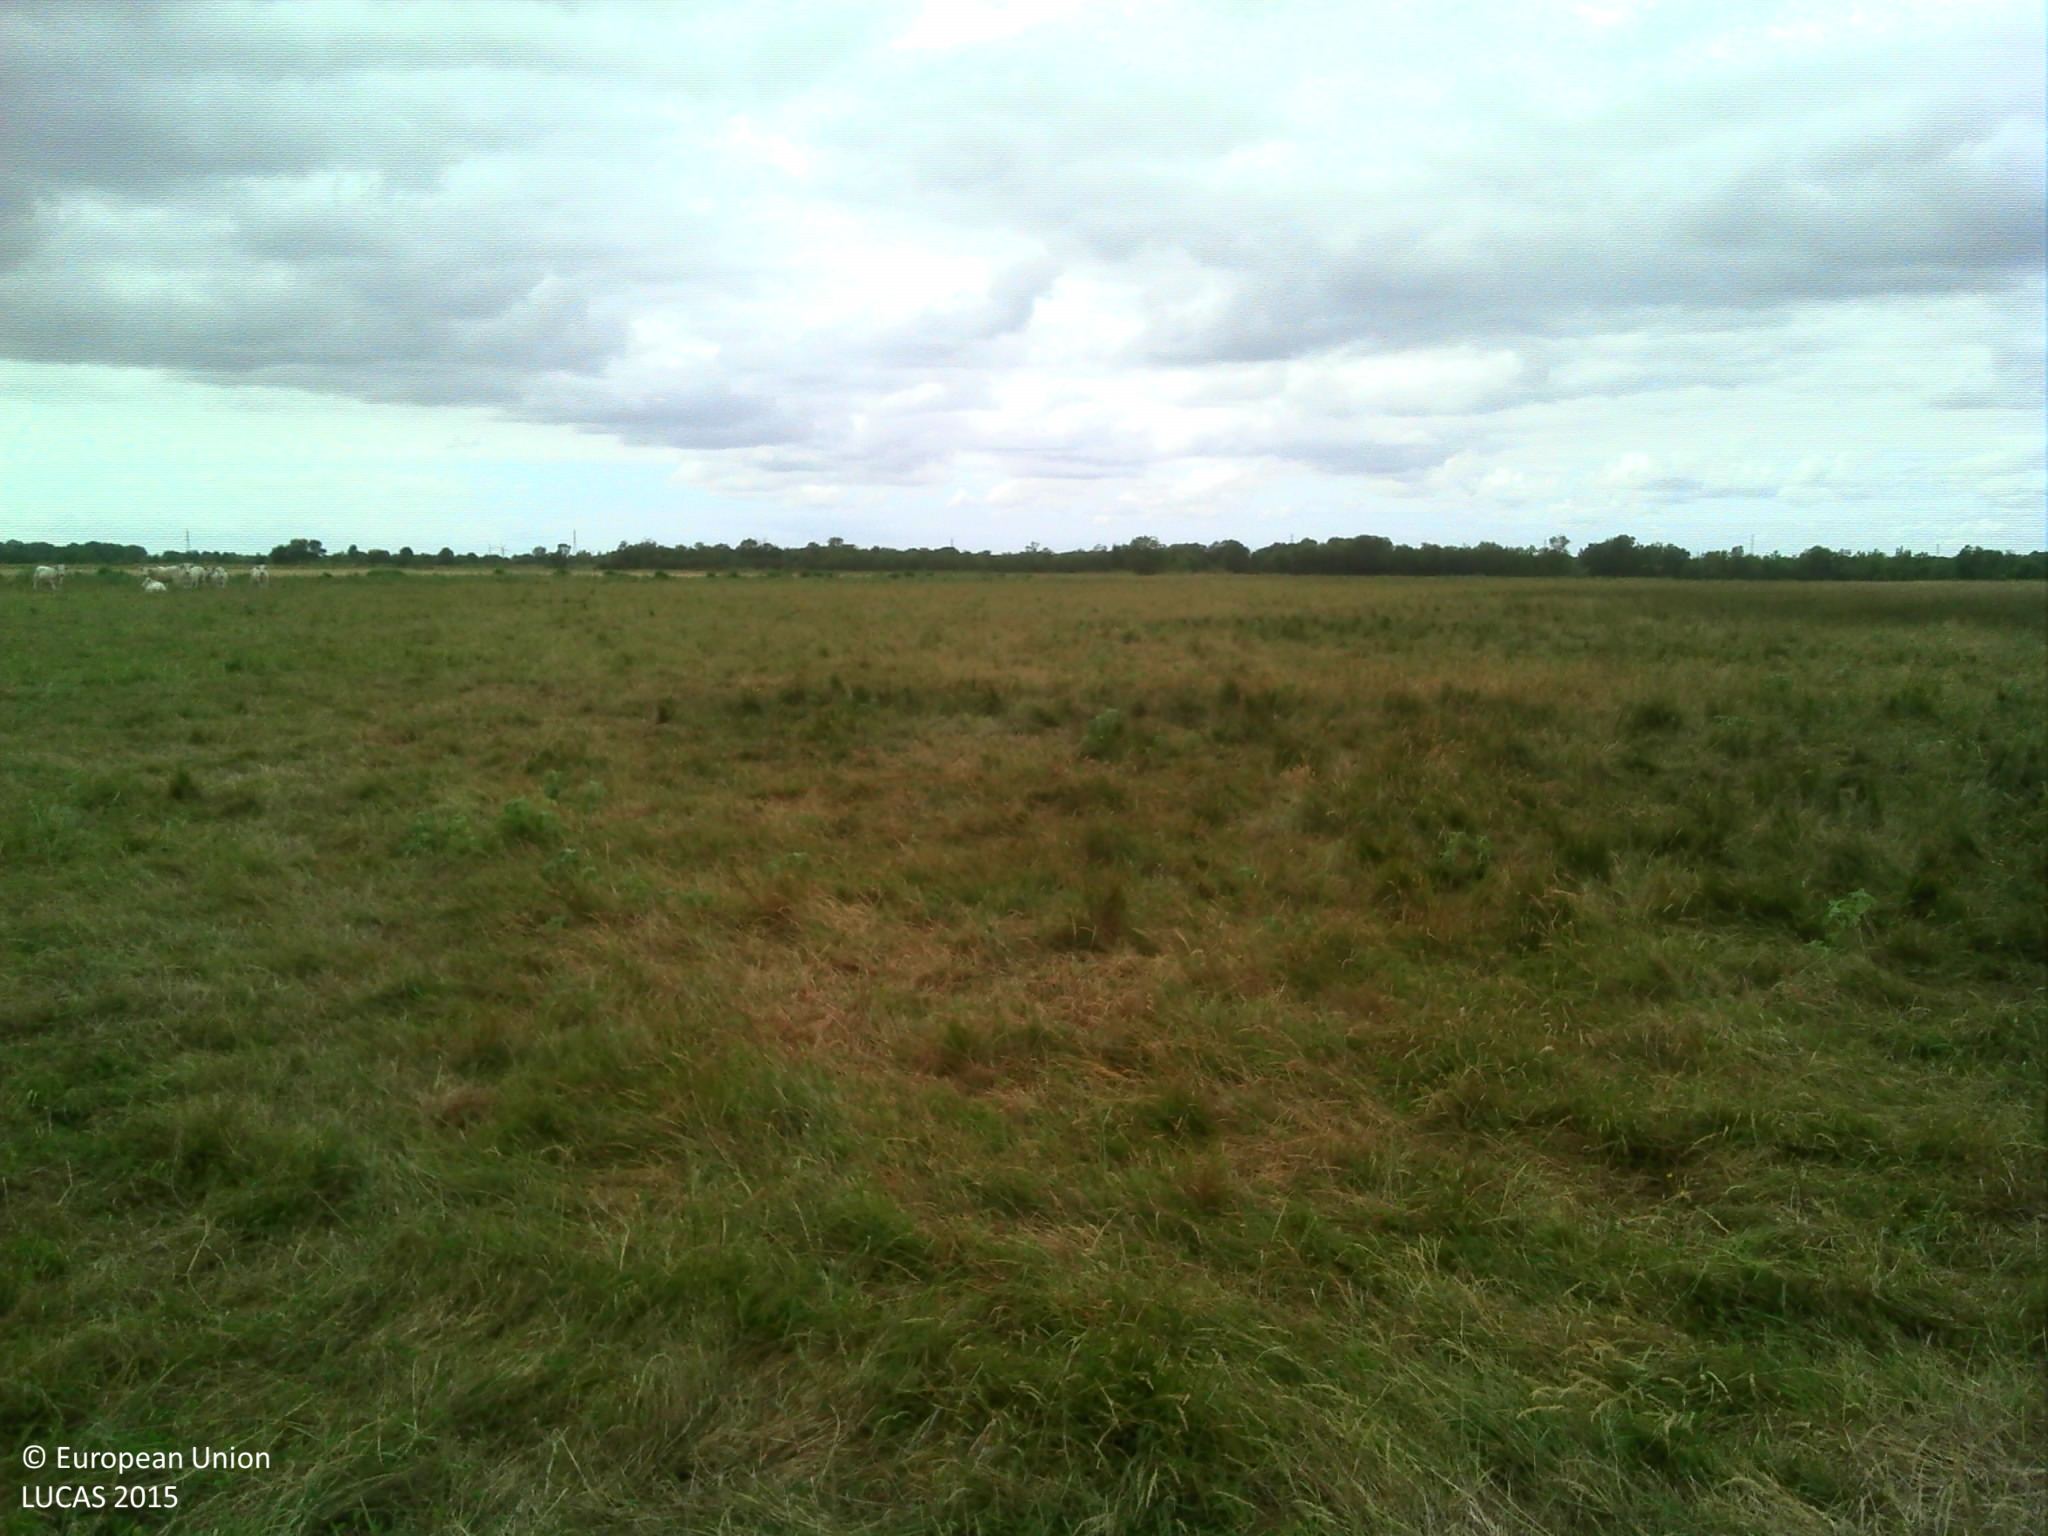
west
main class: Grassland
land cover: Grassland without tree/shrub cover
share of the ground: > 75 %
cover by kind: herbaceous plants 100 %
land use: Agriculture (excluding fallow land and kitchen gardens)
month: July
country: FR
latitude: 46.4240
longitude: -1.2904
